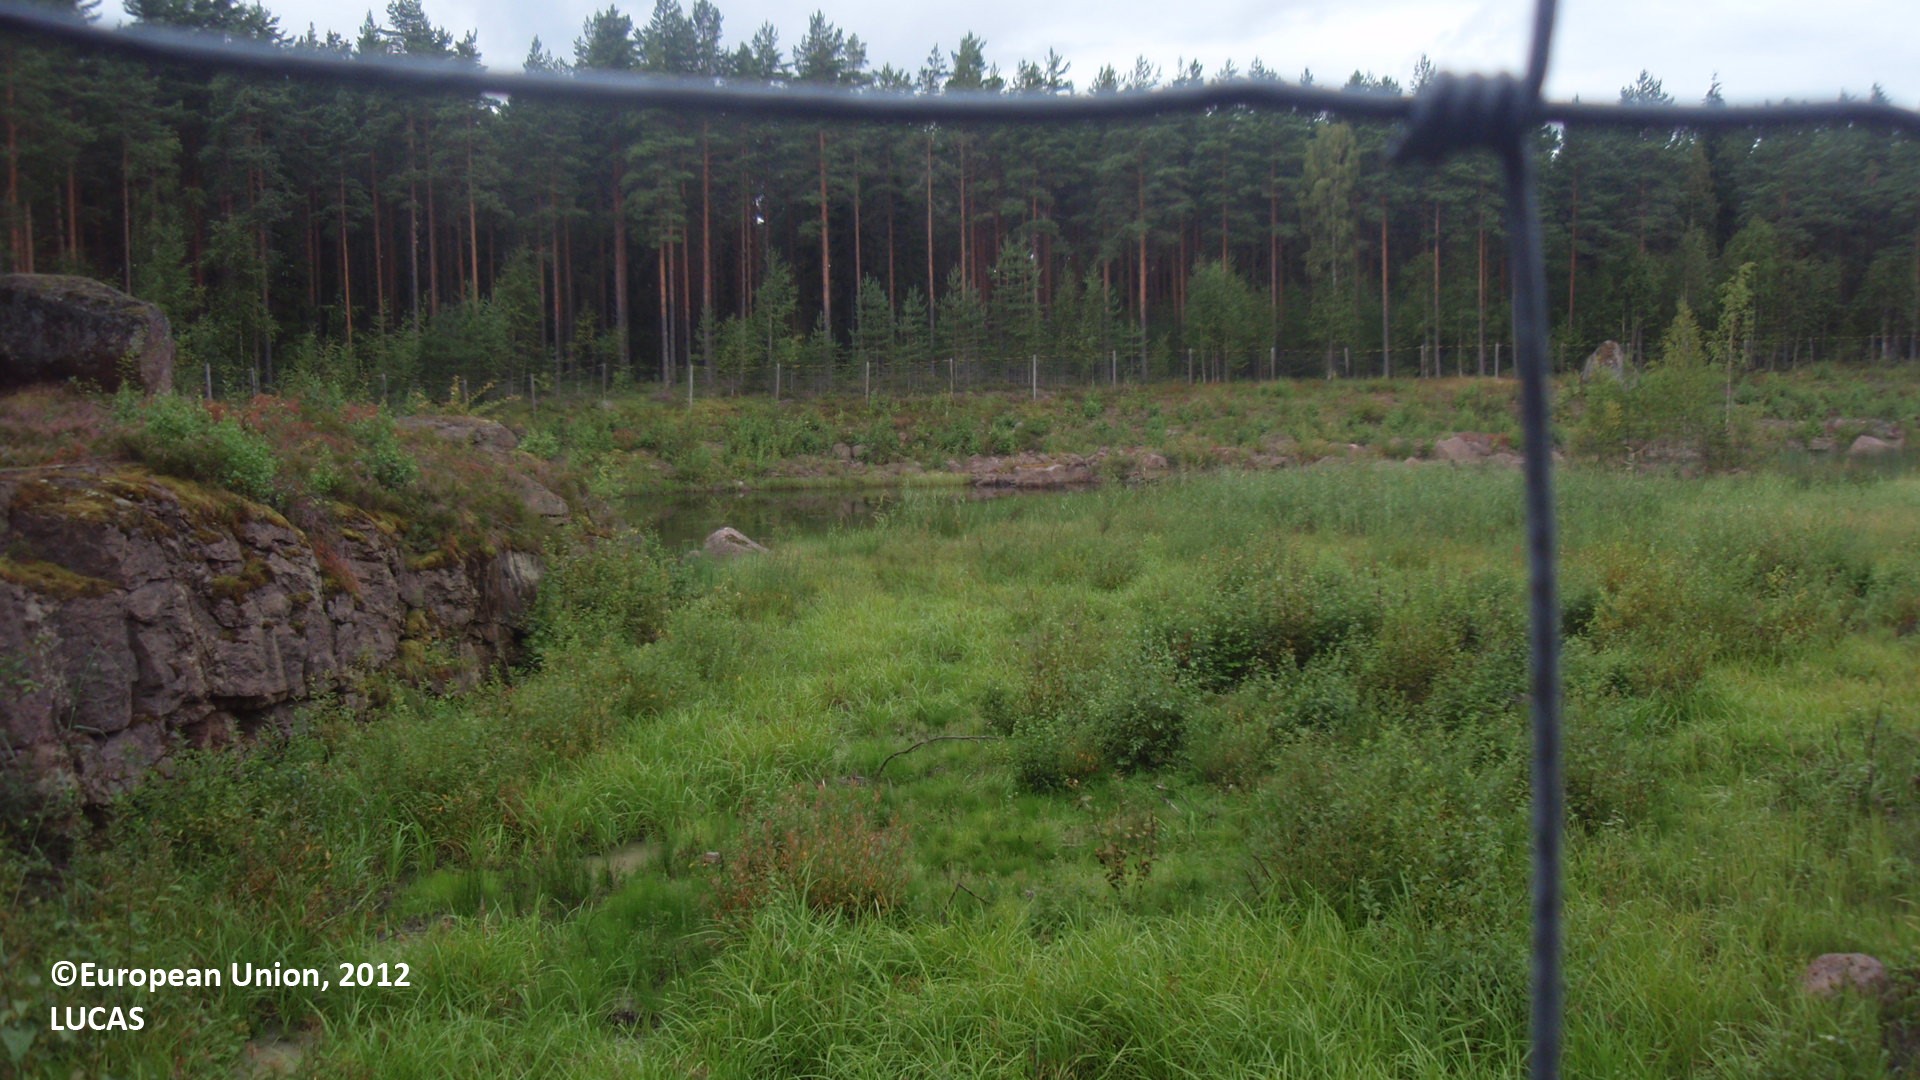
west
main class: Grassland
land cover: Grassland with sparse tree/shrub cover
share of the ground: > 75 %
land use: Abandoned areas
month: August
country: FI
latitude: 60.5683
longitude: 27.0850
